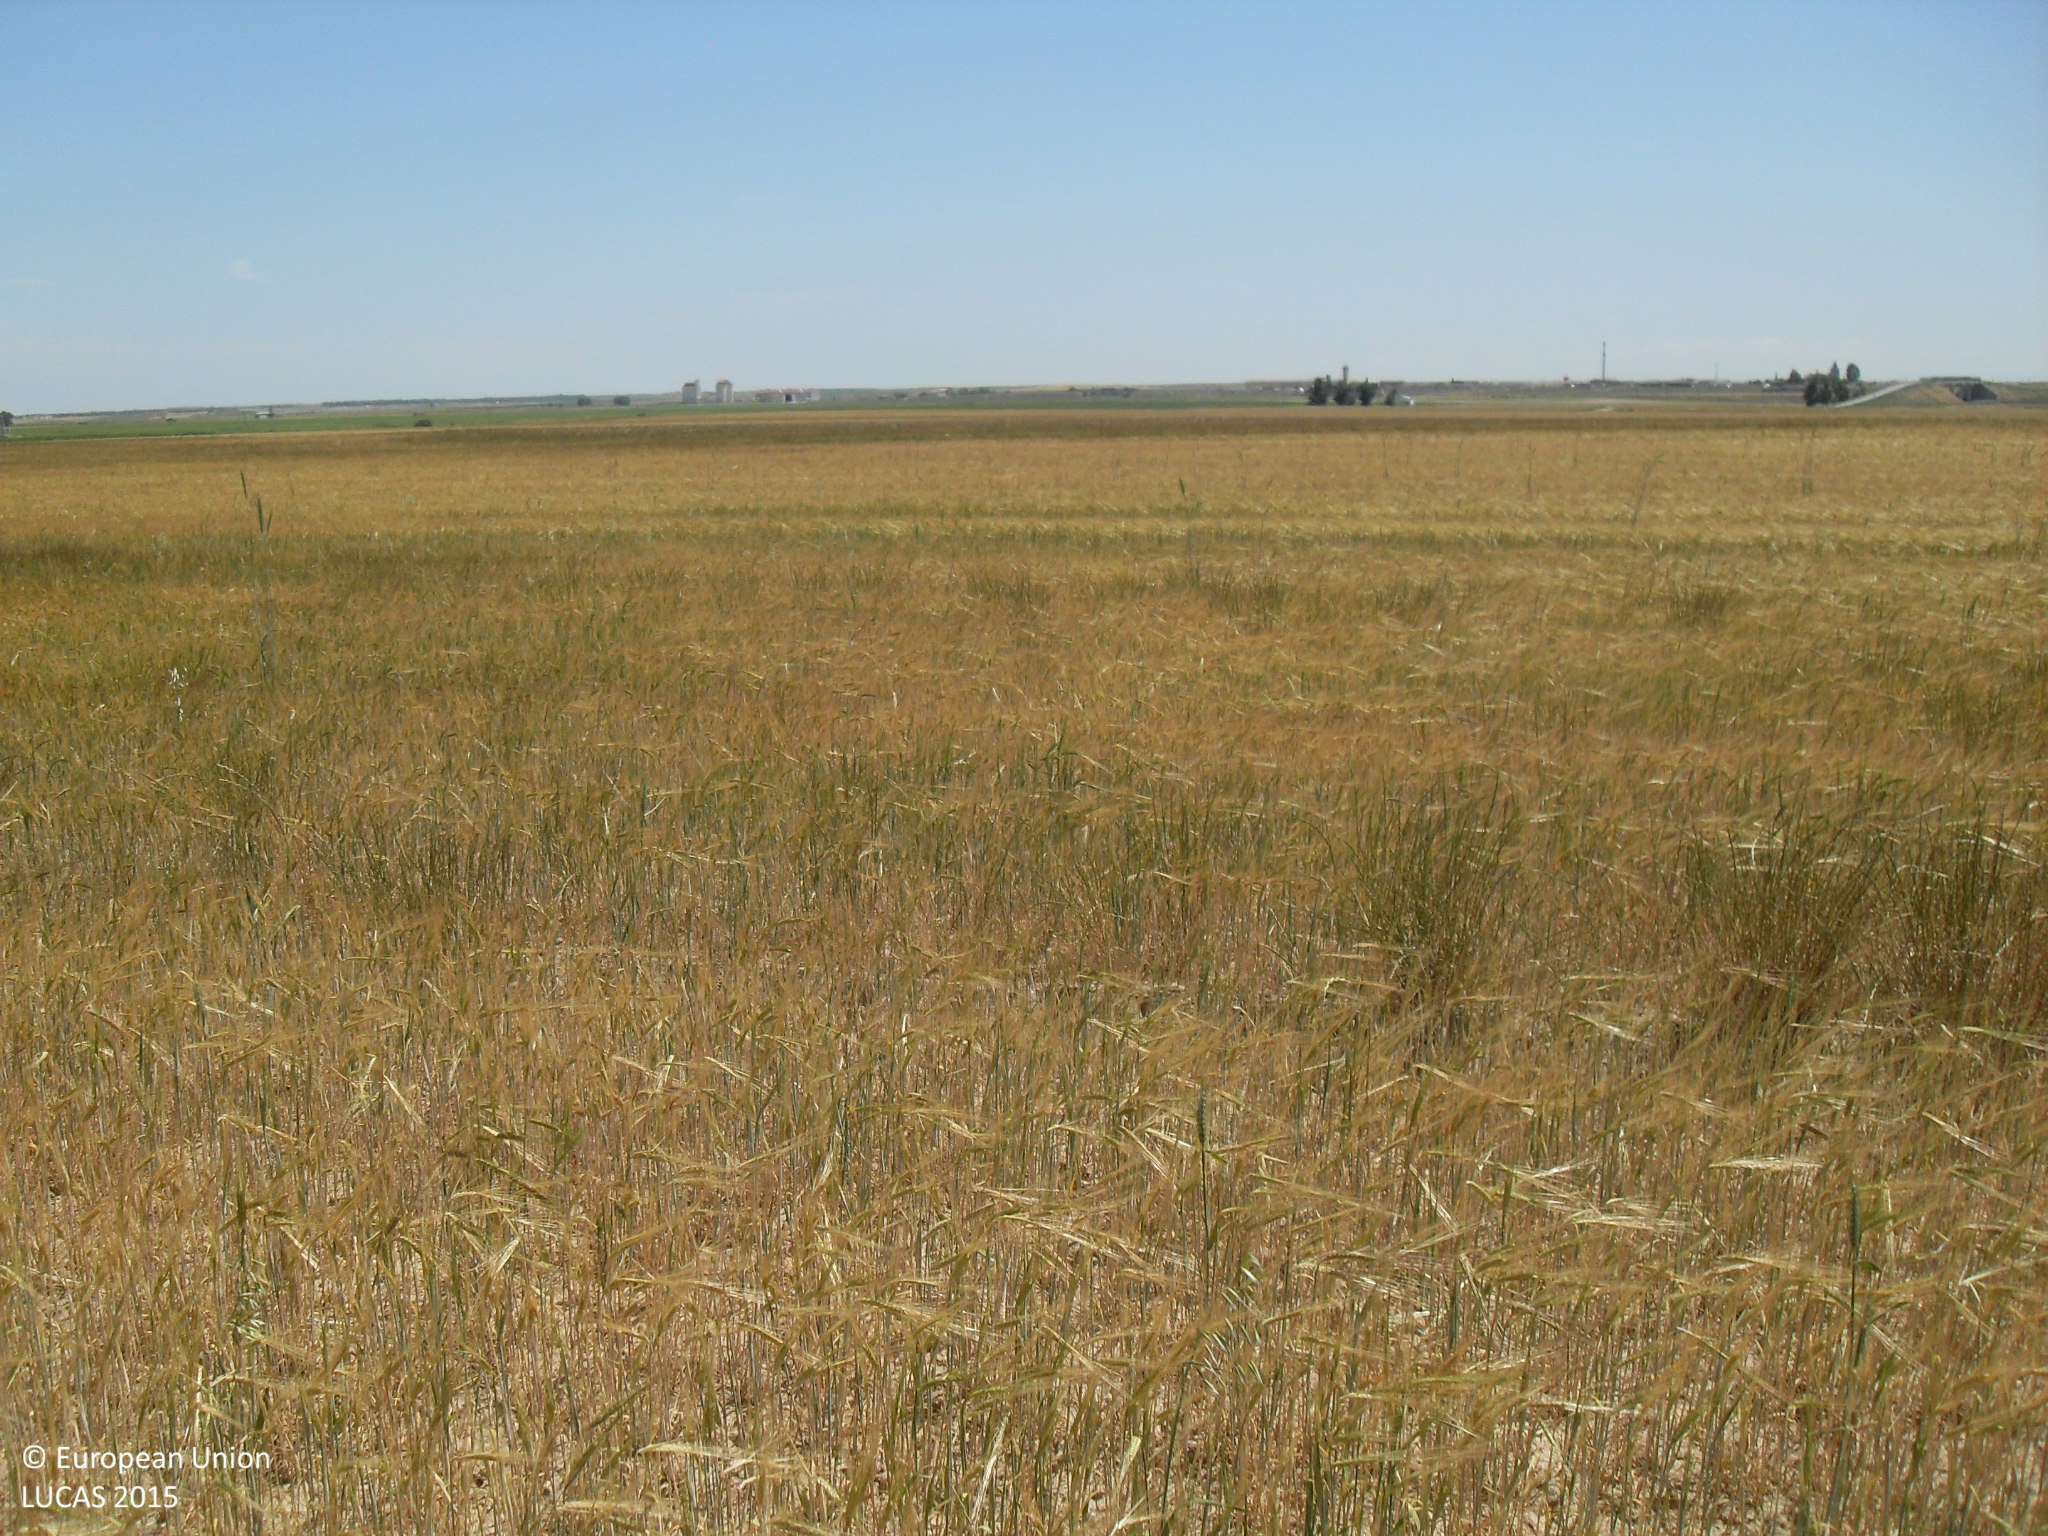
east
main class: Cropland
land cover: Barley
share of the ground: > 75 %
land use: Agriculture (excluding fallow land and kitchen gardens)
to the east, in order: Barley
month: May
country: ES
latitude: 41.1304
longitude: -5.2111
